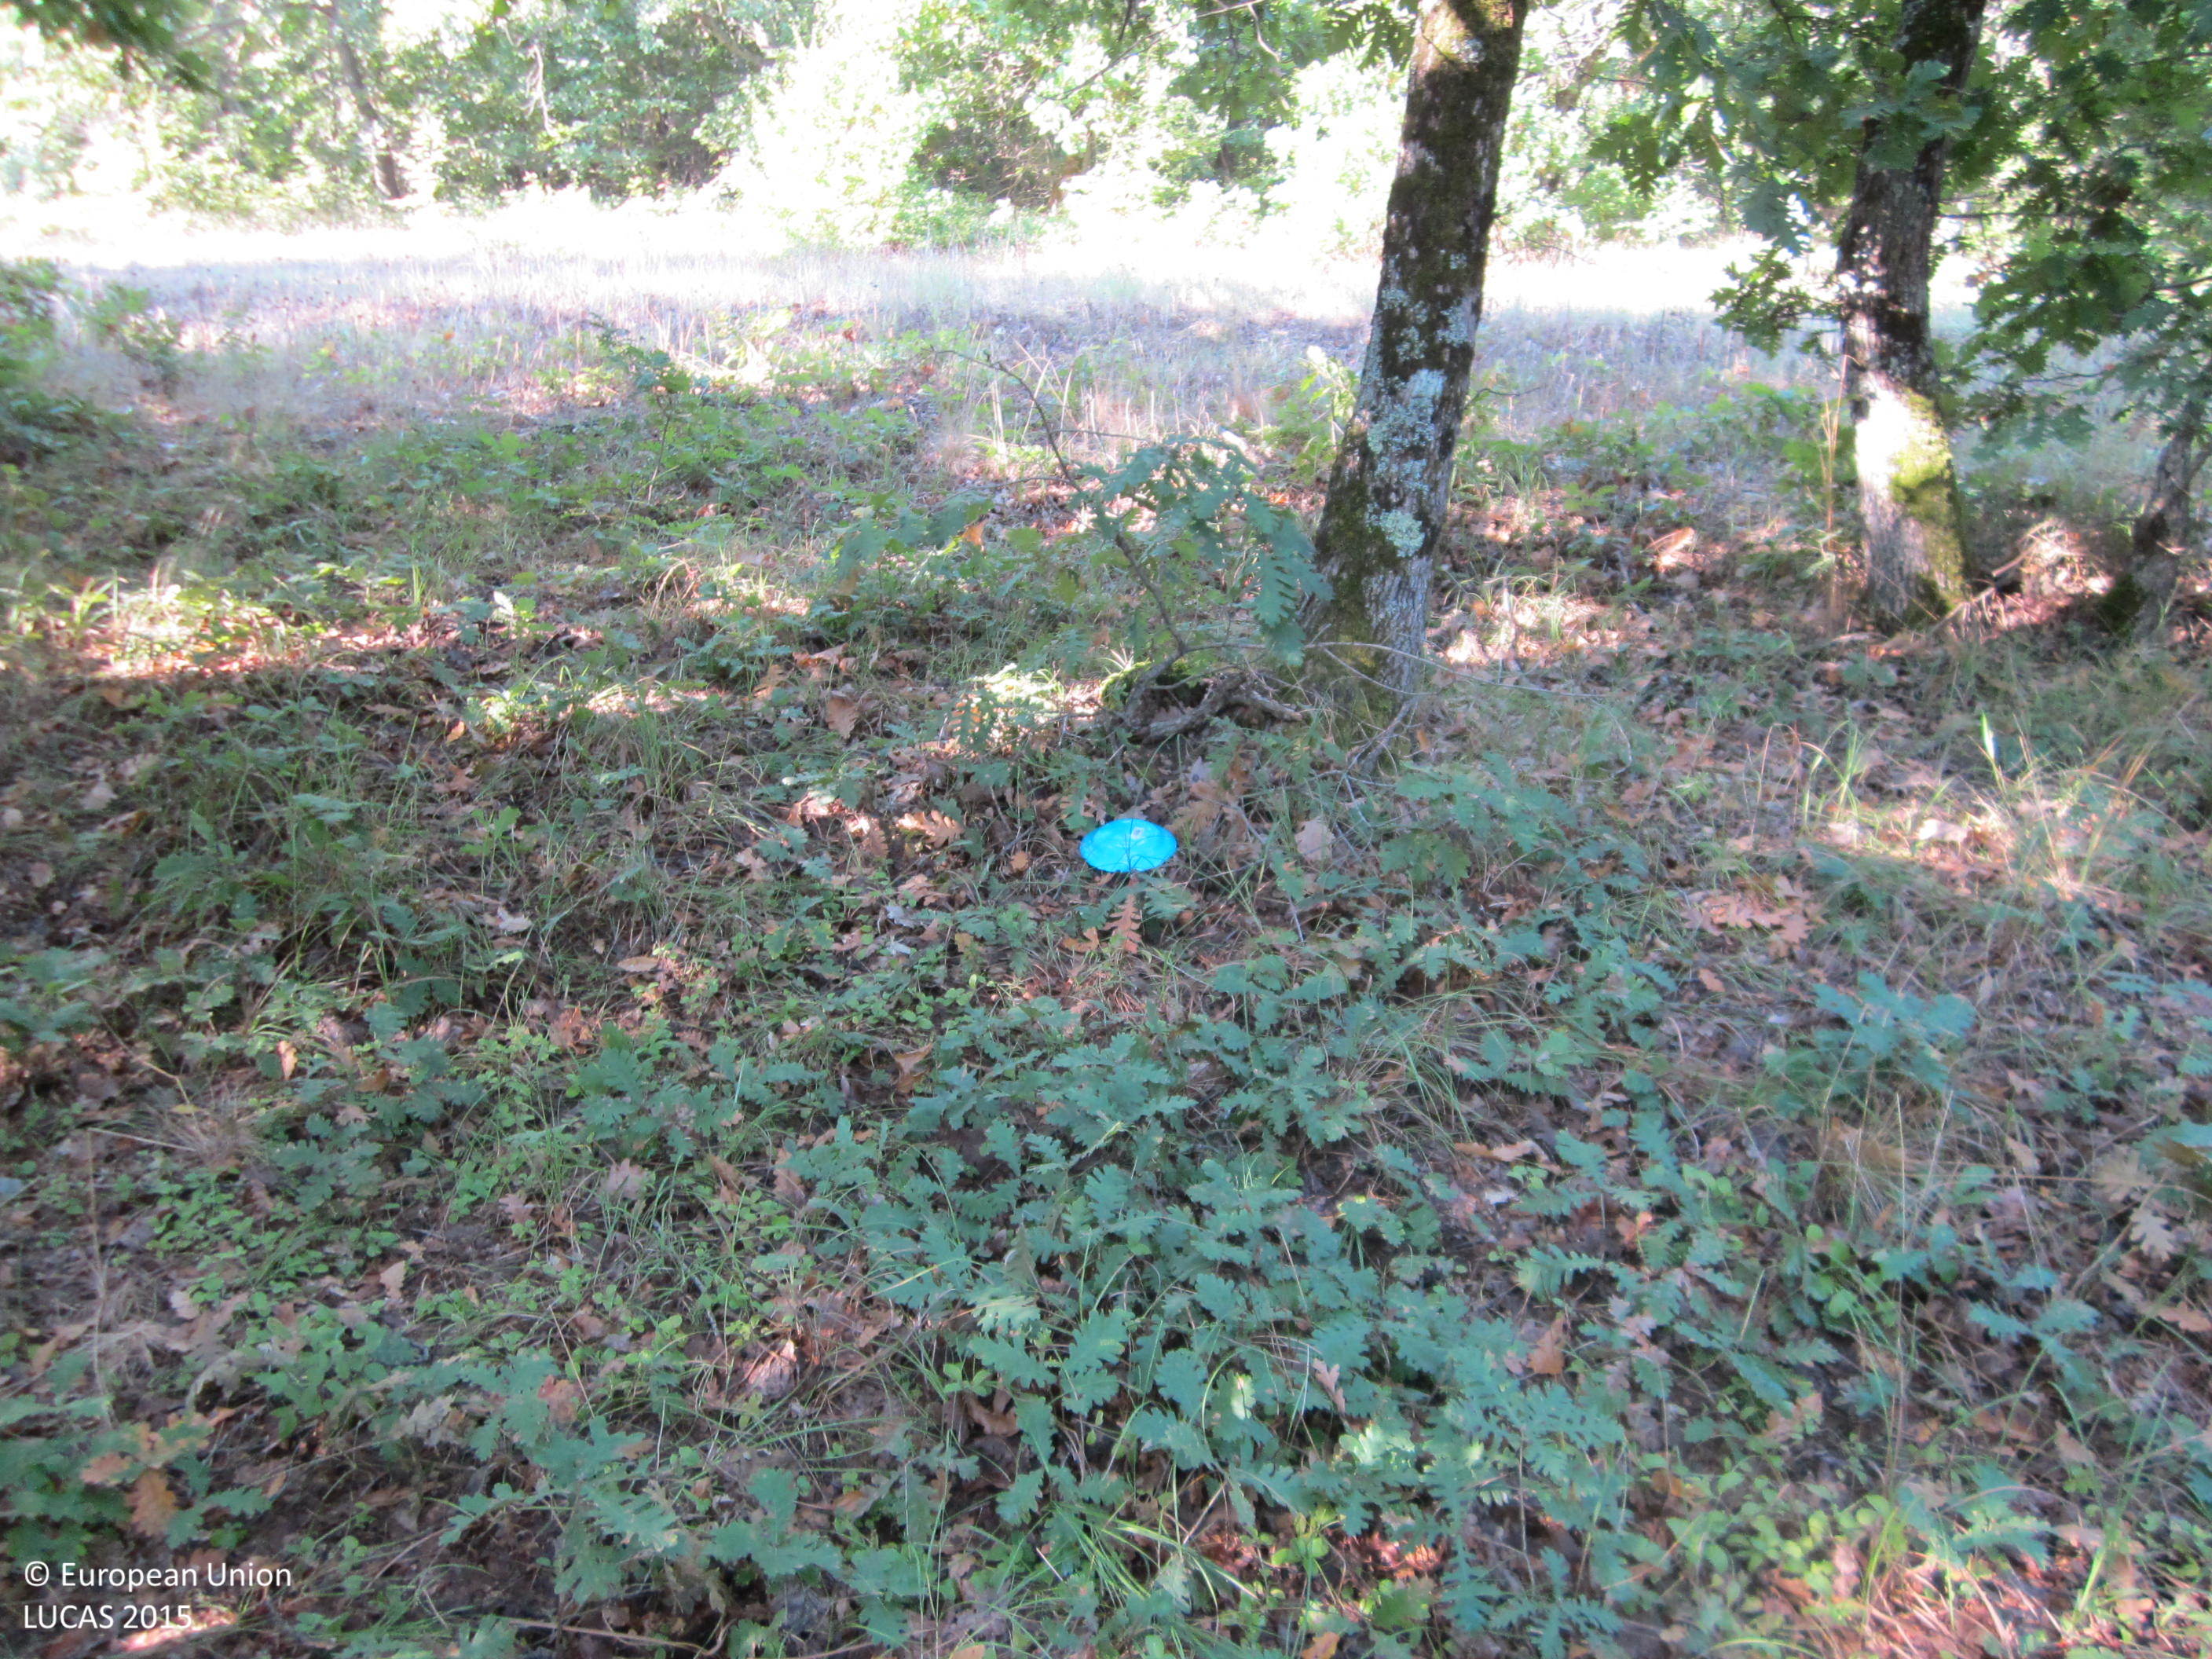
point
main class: Woodland
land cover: Broadleaved woodland
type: thermophilous deciduous forest
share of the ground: 50 - 75 %
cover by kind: broadleaved forest trees 65 %, herbaceous plants 30 %, lichens and mosses 5 %
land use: Forestry
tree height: > 5 m
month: September
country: BG
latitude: 42.3693
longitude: 27.2932
